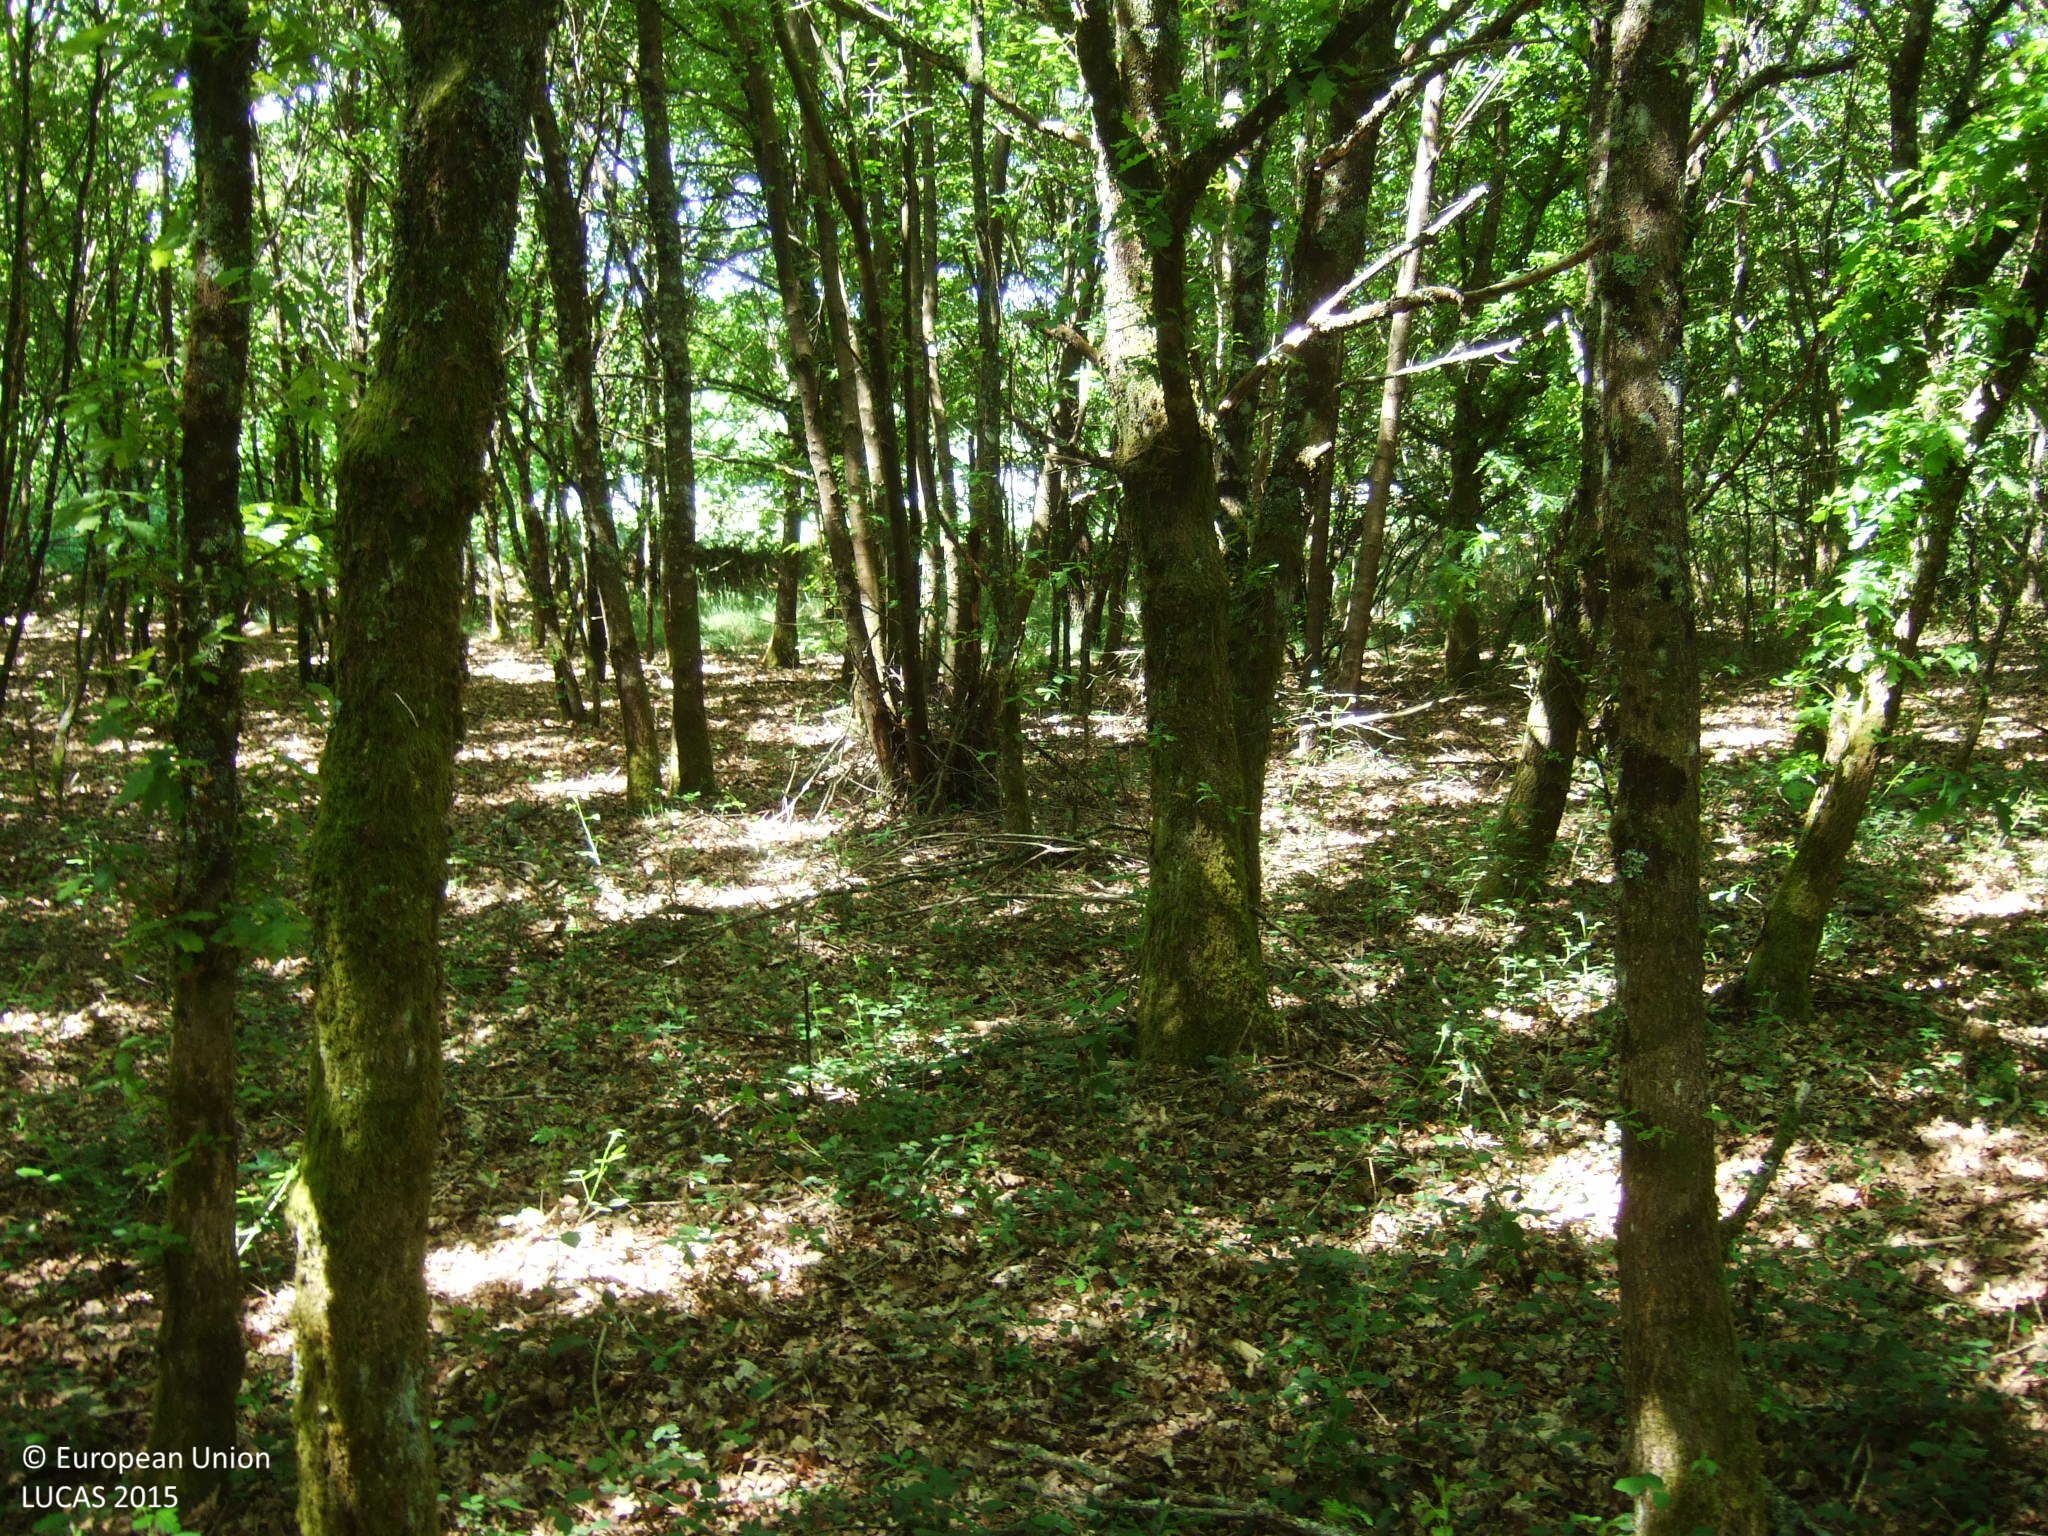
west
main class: Woodland
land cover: Broadleaved woodland
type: acidophilous oak and oak-birch forest
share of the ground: > 75 %
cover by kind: broadleaved forest trees 85 %, shrubs 10 %, unconsolidated bare surface 5 %
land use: Forestry
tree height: > 5 m
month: May
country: ES
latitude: 43.1761
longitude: -7.7377
